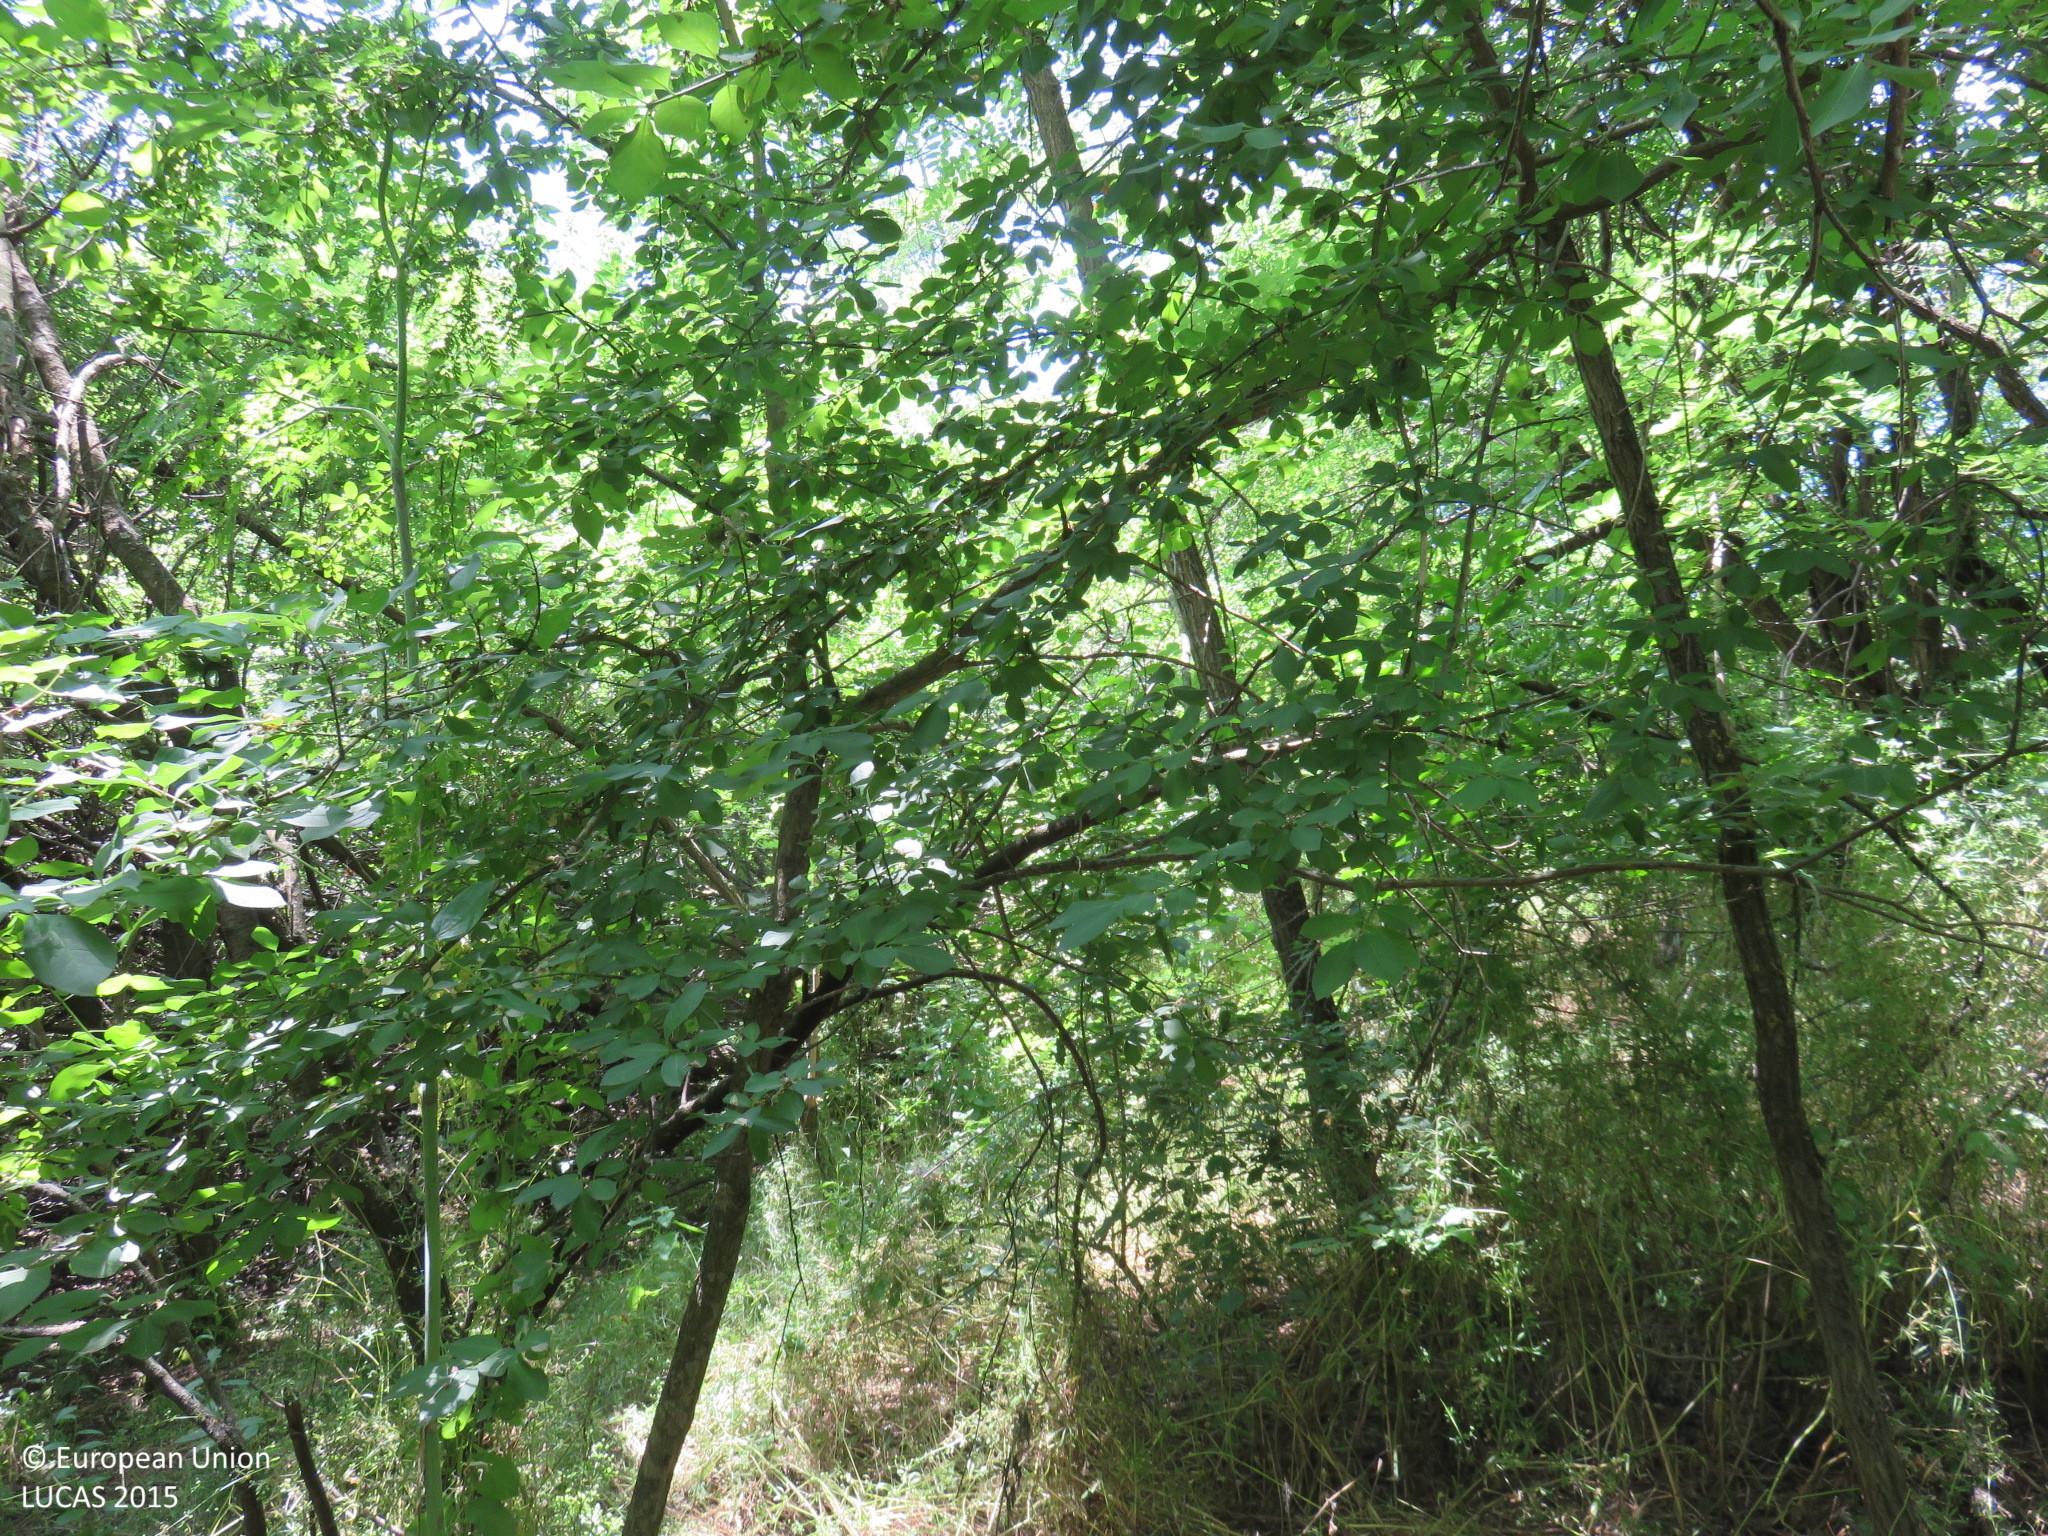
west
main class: Woodland
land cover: Broadleaved woodland
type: mesophytic deciduous forest
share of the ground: > 75 %
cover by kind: broadleaved forest trees 80 %, shrubs 10 %, herbaceous plants 10 %
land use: Forestry
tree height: < 5 m
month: June
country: BG
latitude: 43.2761
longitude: 24.4631
